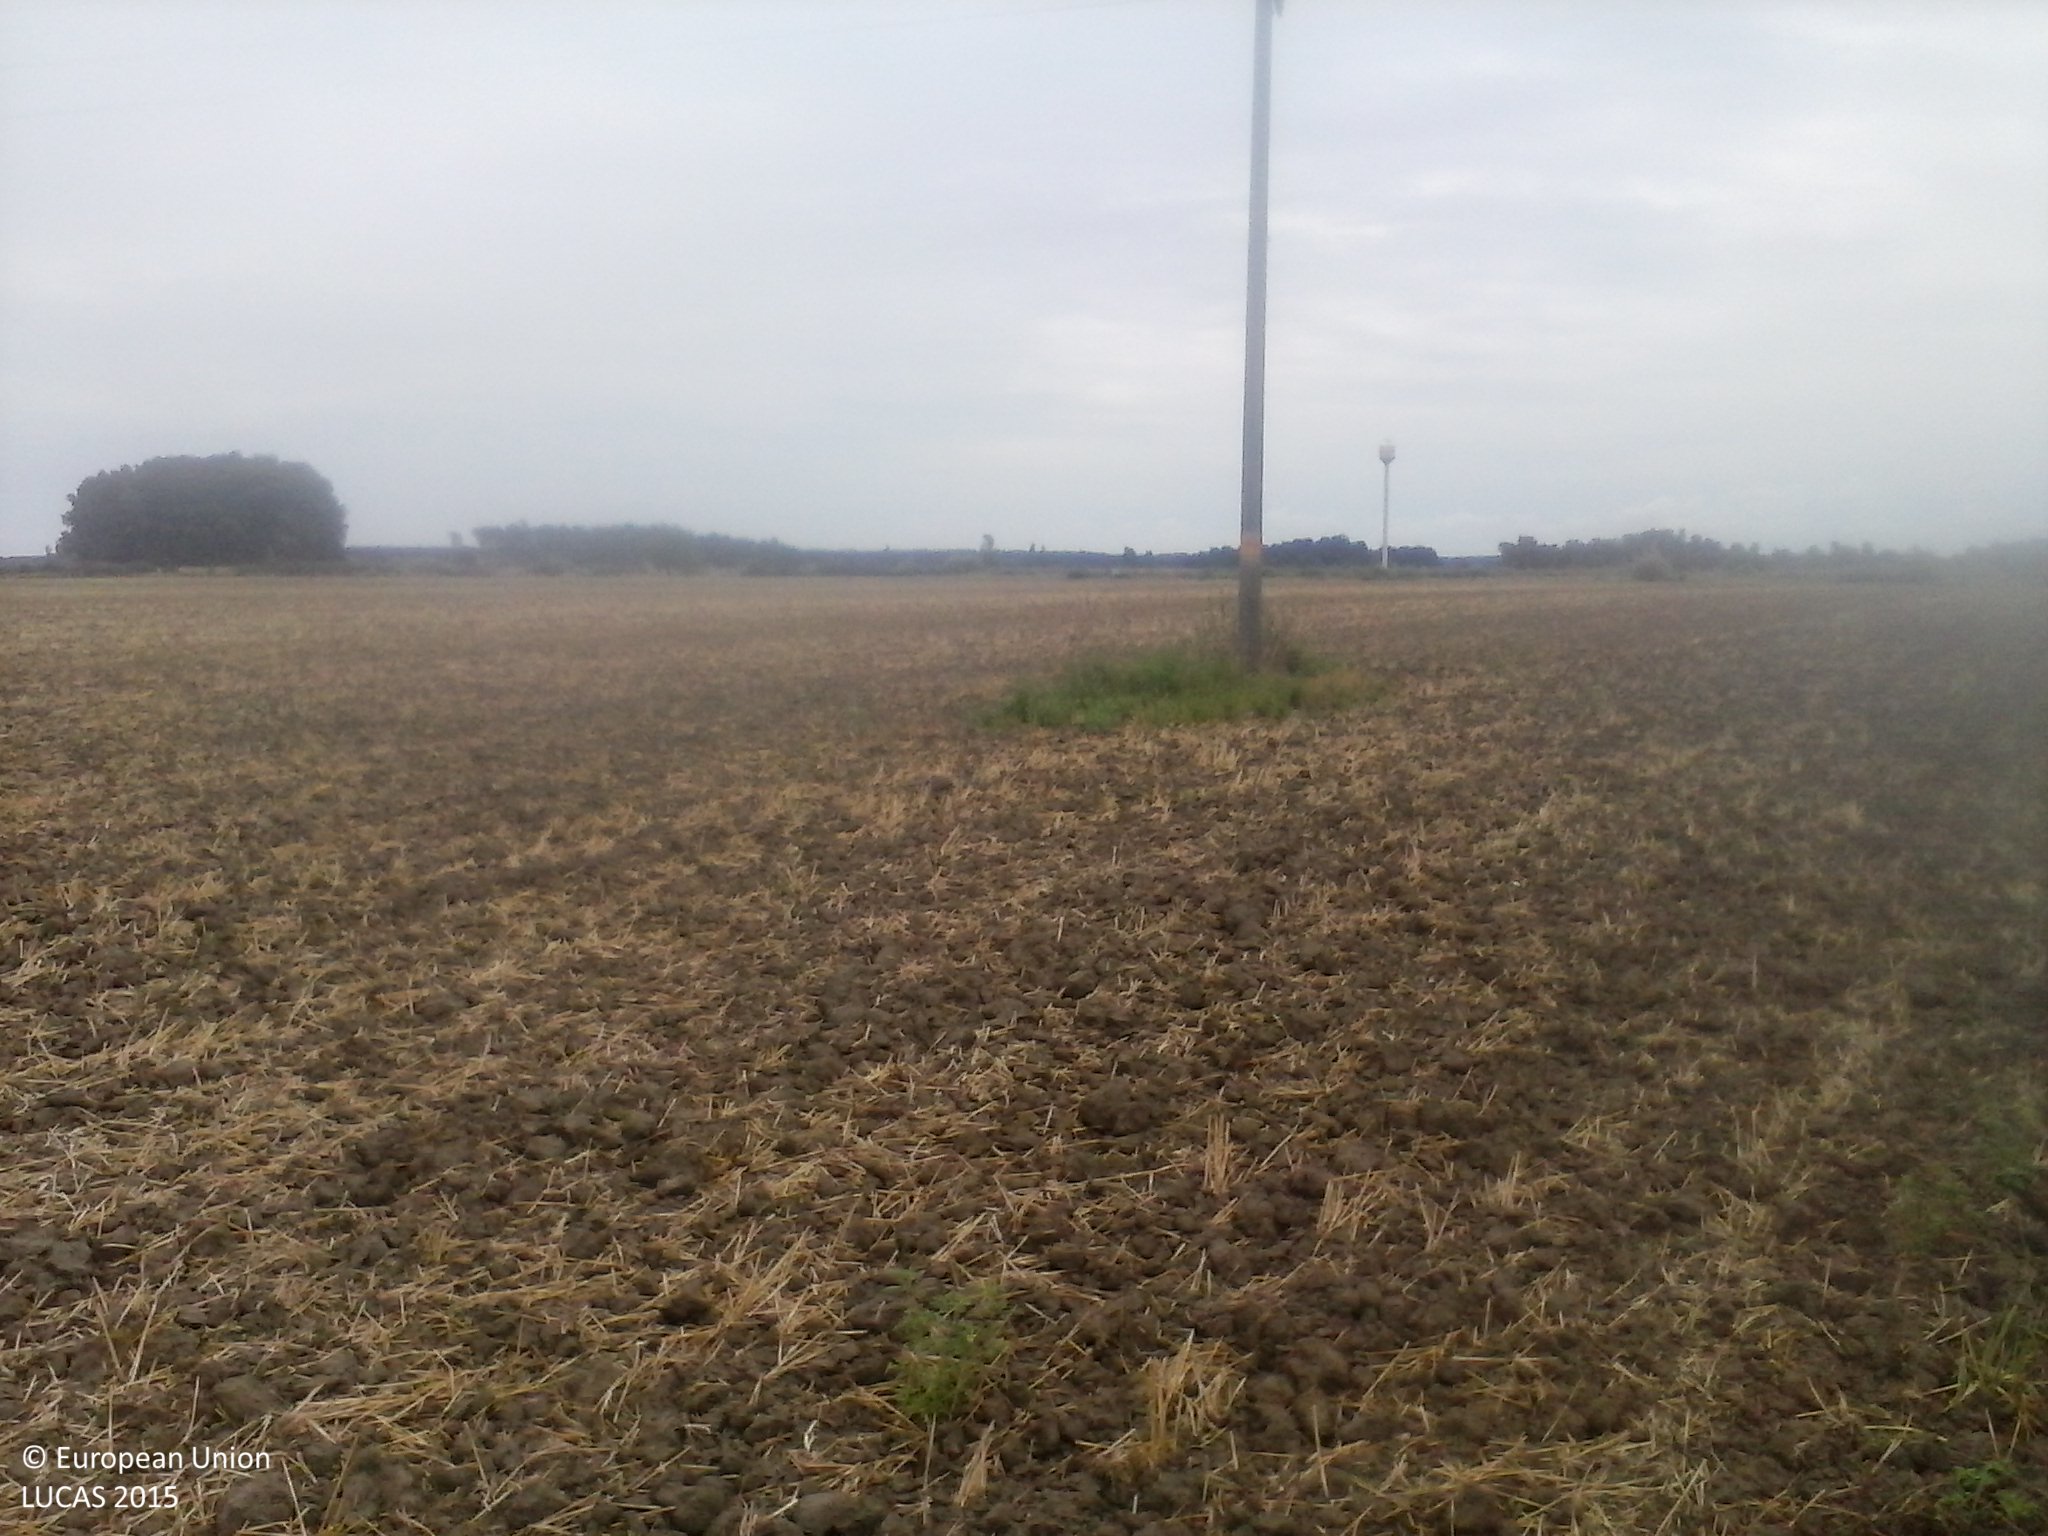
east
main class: Cropland
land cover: Maize
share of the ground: > 75 %
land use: Agriculture (excluding fallow land and kitchen gardens)
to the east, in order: Maize; Grass margins; Common wheat; Electric lines; Common wheat
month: July
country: HU
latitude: 45.9803
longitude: 17.7361
